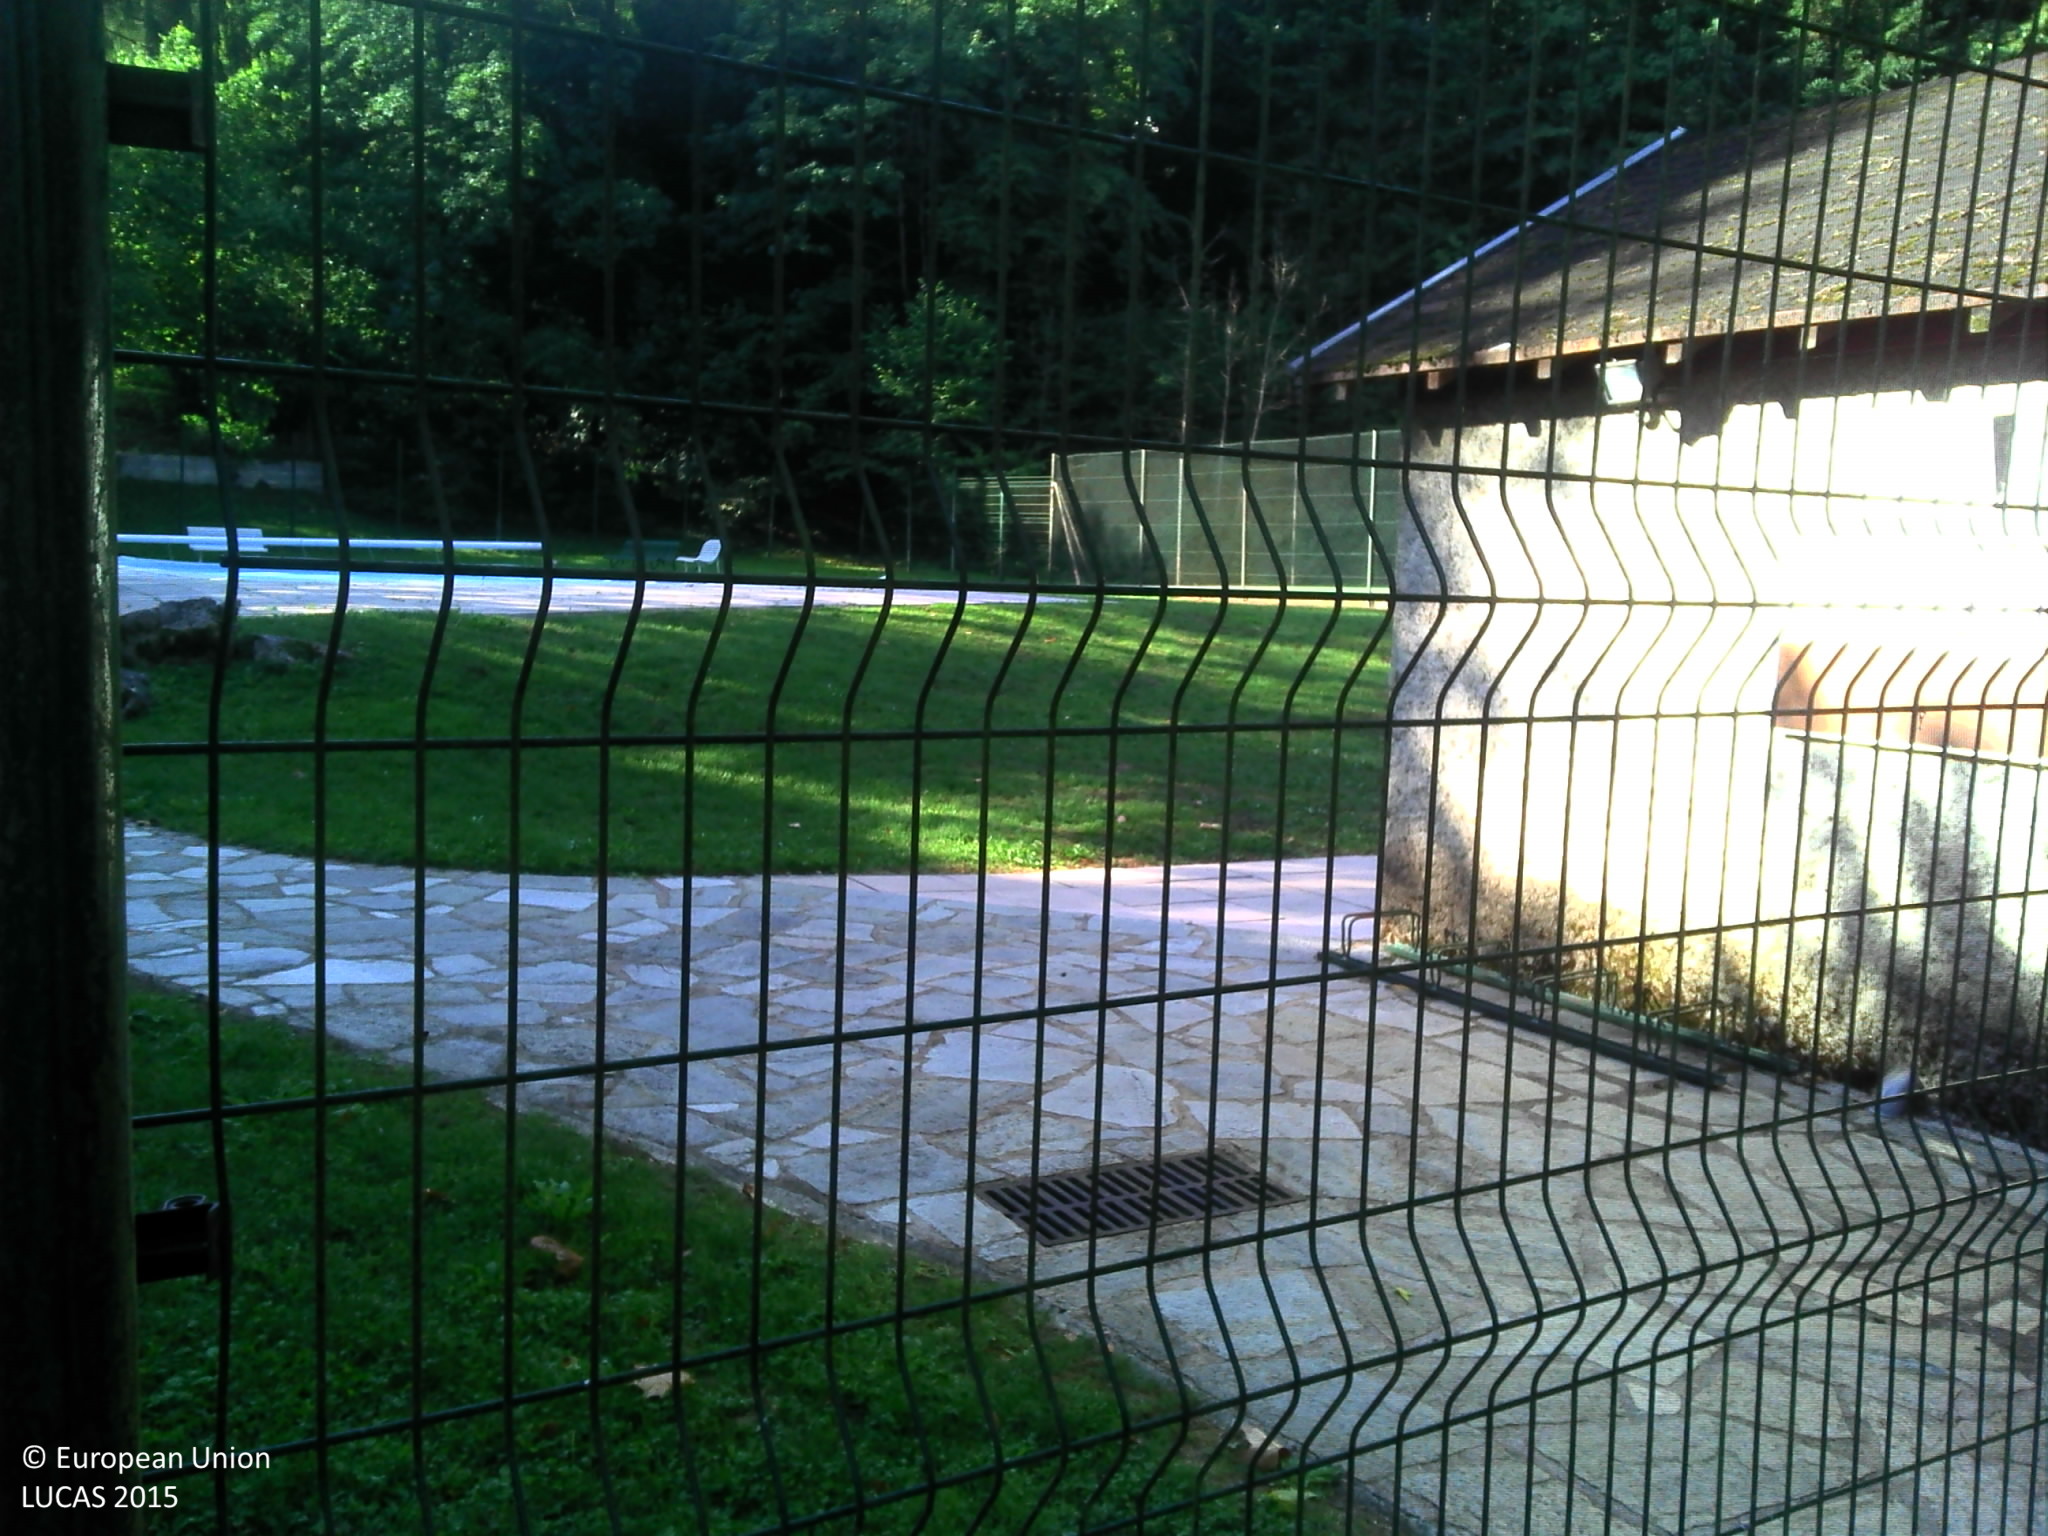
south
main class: Grassland
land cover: Grassland without tree/shrub cover
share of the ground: > 75 %
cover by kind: herbaceous plants 70 %, consolidated bare surface 10 %
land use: Amenities, museums, leisure
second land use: Sport
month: September
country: FR
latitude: 47.3228
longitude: 6.0191
